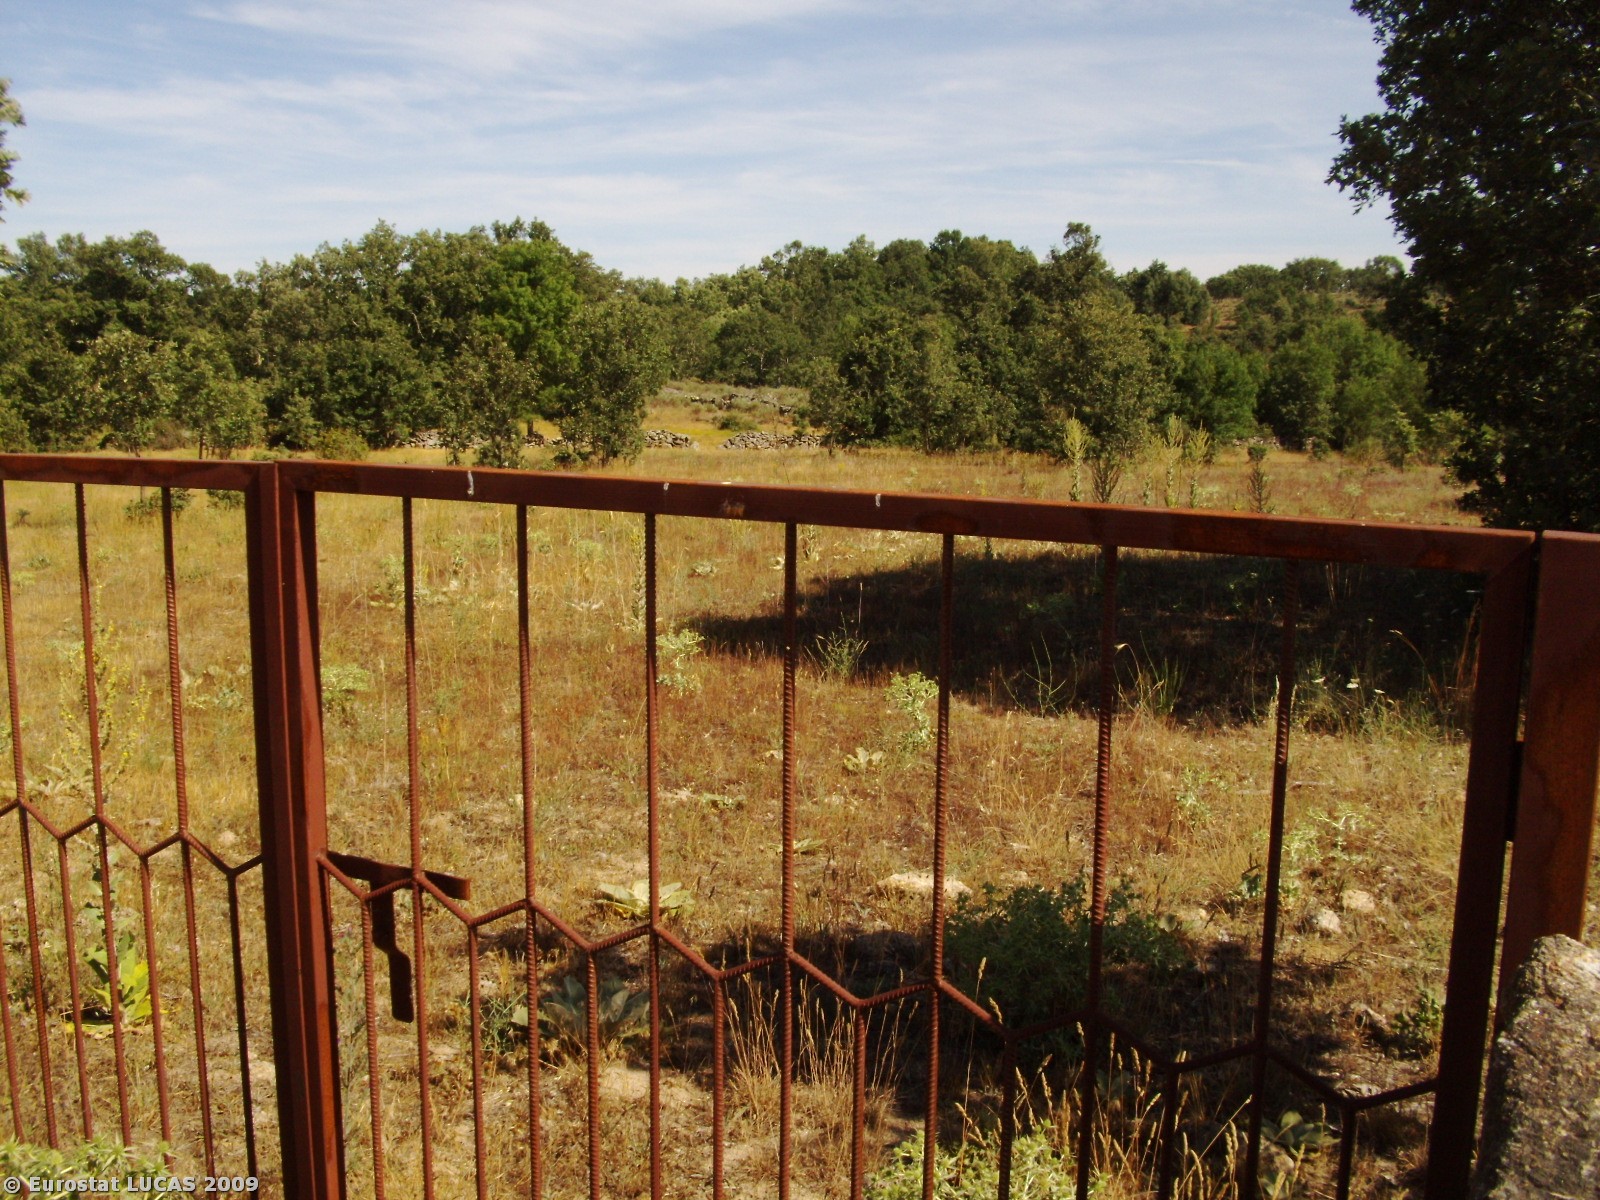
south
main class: Grassland
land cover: Spontaneously vegetated surfaces
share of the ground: > 75 %
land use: Fallow land
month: July
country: PT
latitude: 40.3726
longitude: -6.8046
